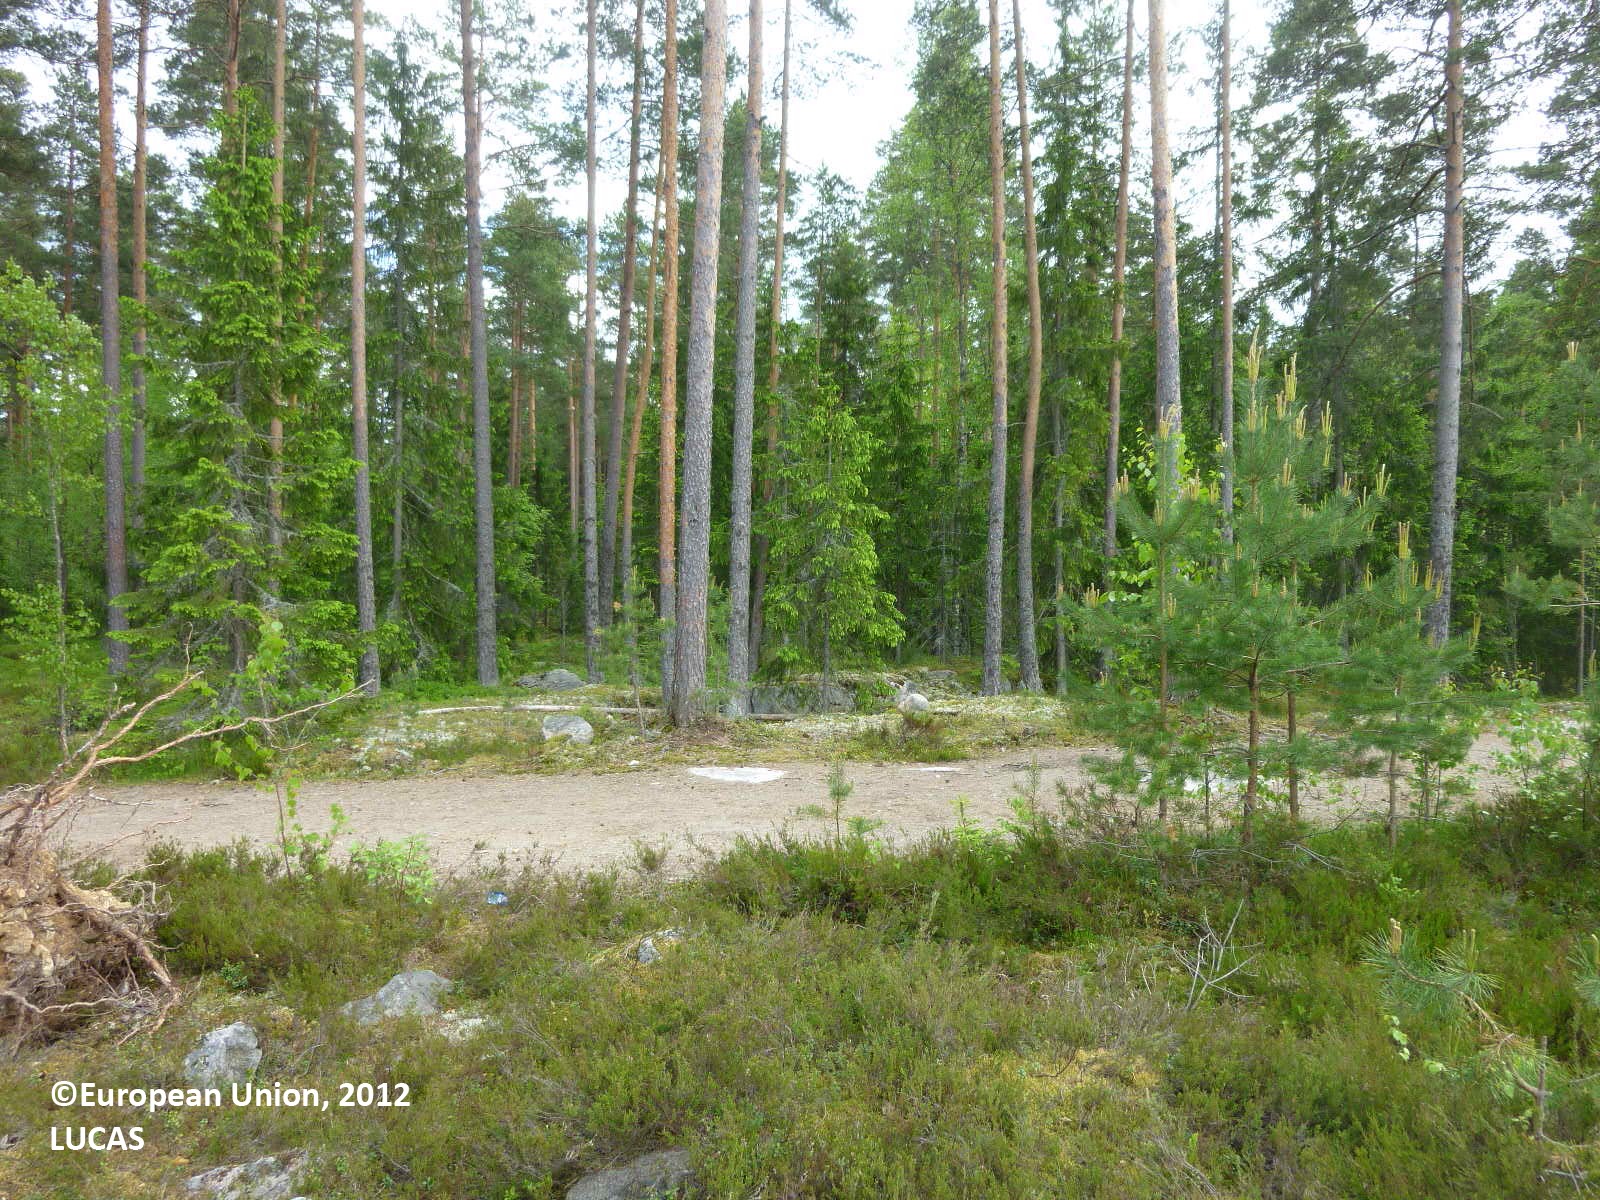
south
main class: Woodland
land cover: Pine dominated coniferous woodland
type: boreal forest
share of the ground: 25 - 50 %
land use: Forestry
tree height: > 5 m
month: June
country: FI
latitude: 60.5850
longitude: 22.7597
